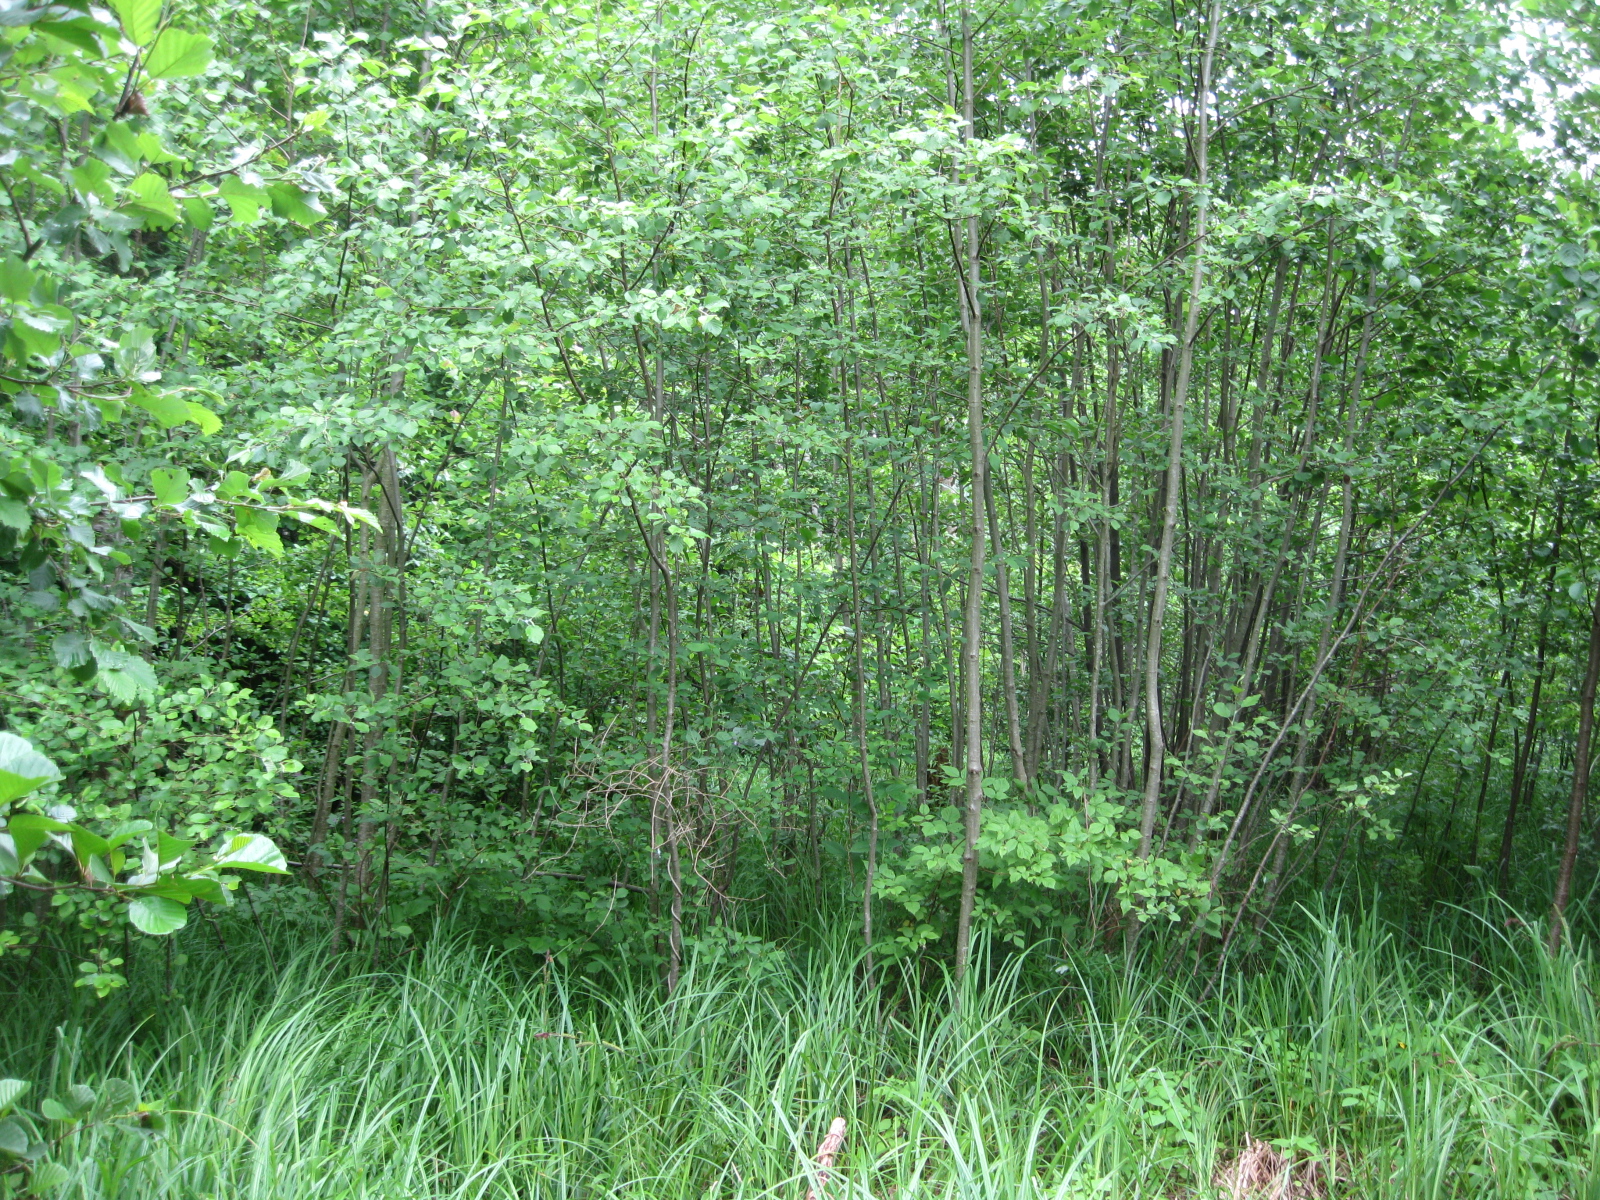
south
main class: Woodland
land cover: Broadleaved woodland
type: non-riverine alder, birch or aspen forest
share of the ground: > 75 %
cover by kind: broadleaved forest trees 80 %, herbaceous plants 15 %, shrubs 5 %
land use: Forestry
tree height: < 5 m
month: June
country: LT
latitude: 55.1016
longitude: 24.0240
